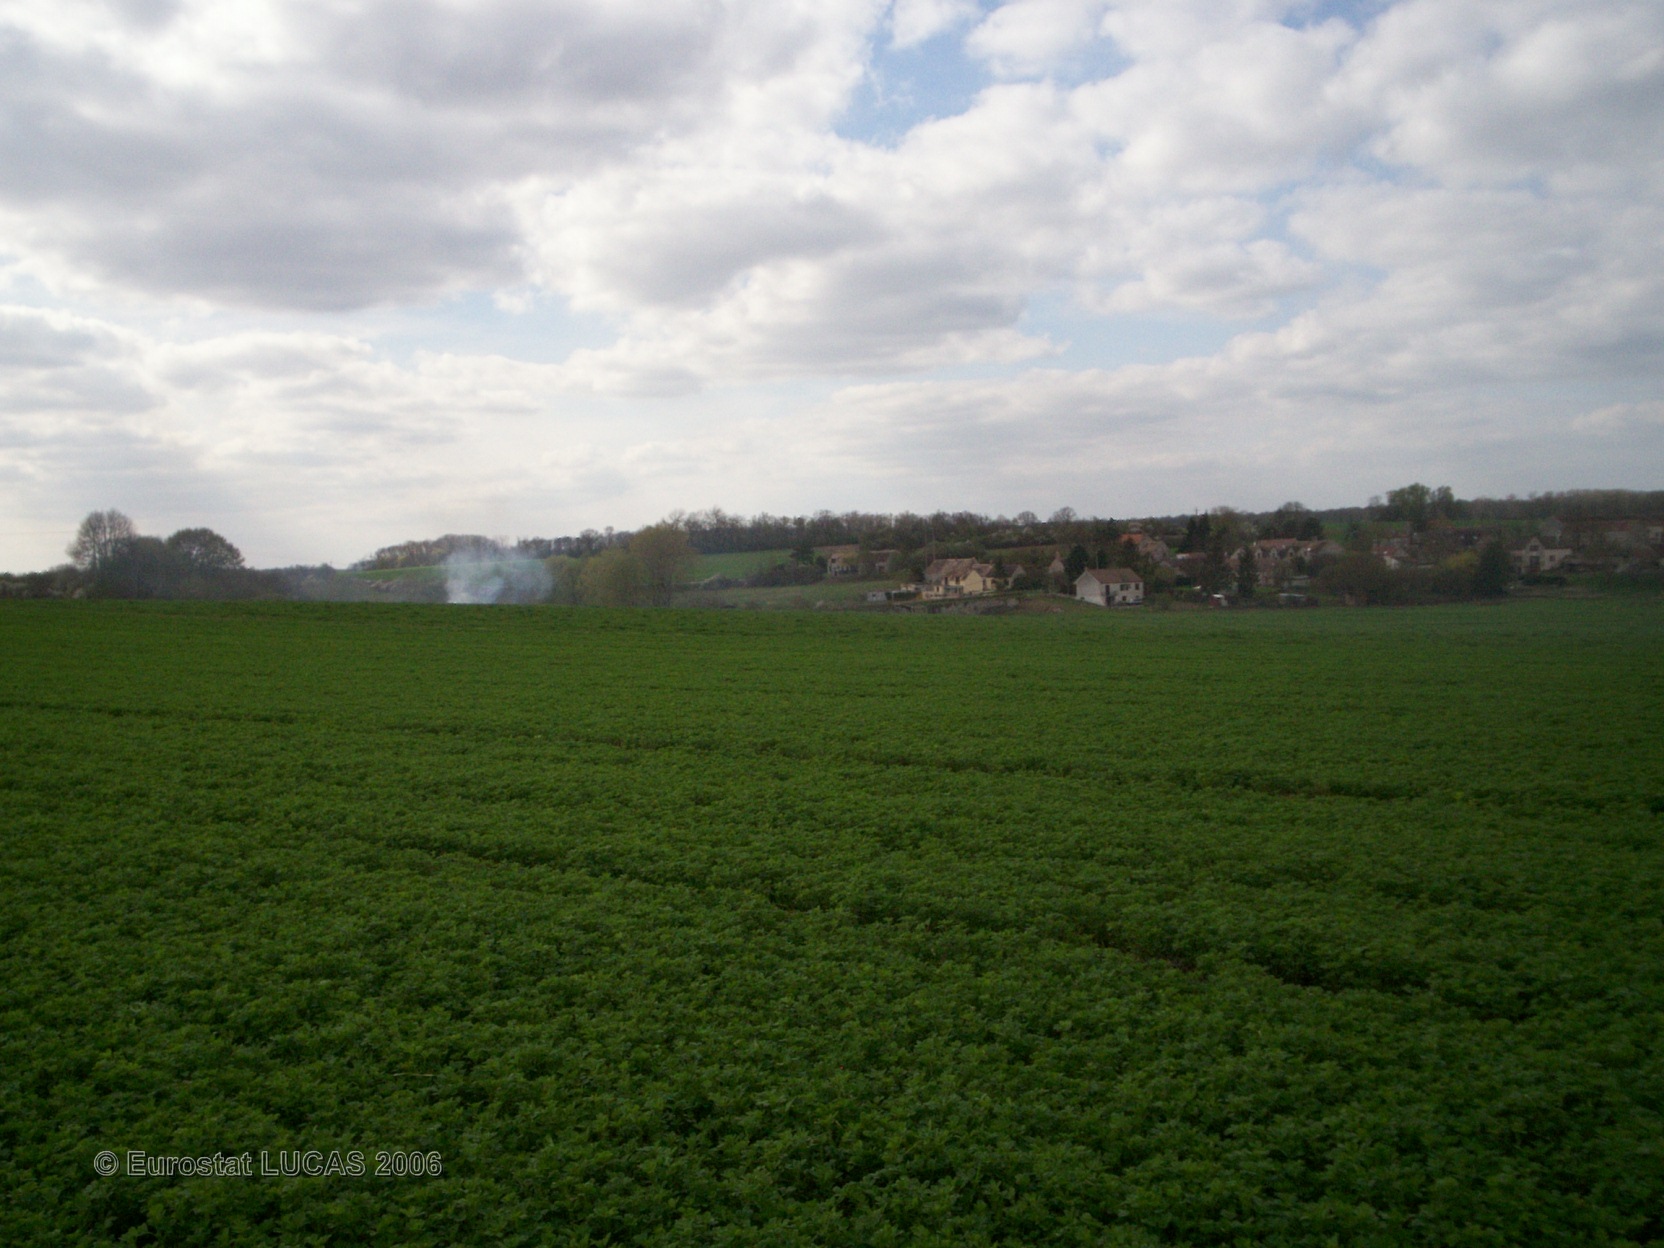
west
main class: Cropland
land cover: Lucerne
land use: Agriculture (excluding fallow land and kitchen gardens)
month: April
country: FR
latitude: 48.4474
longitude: 2.9208
